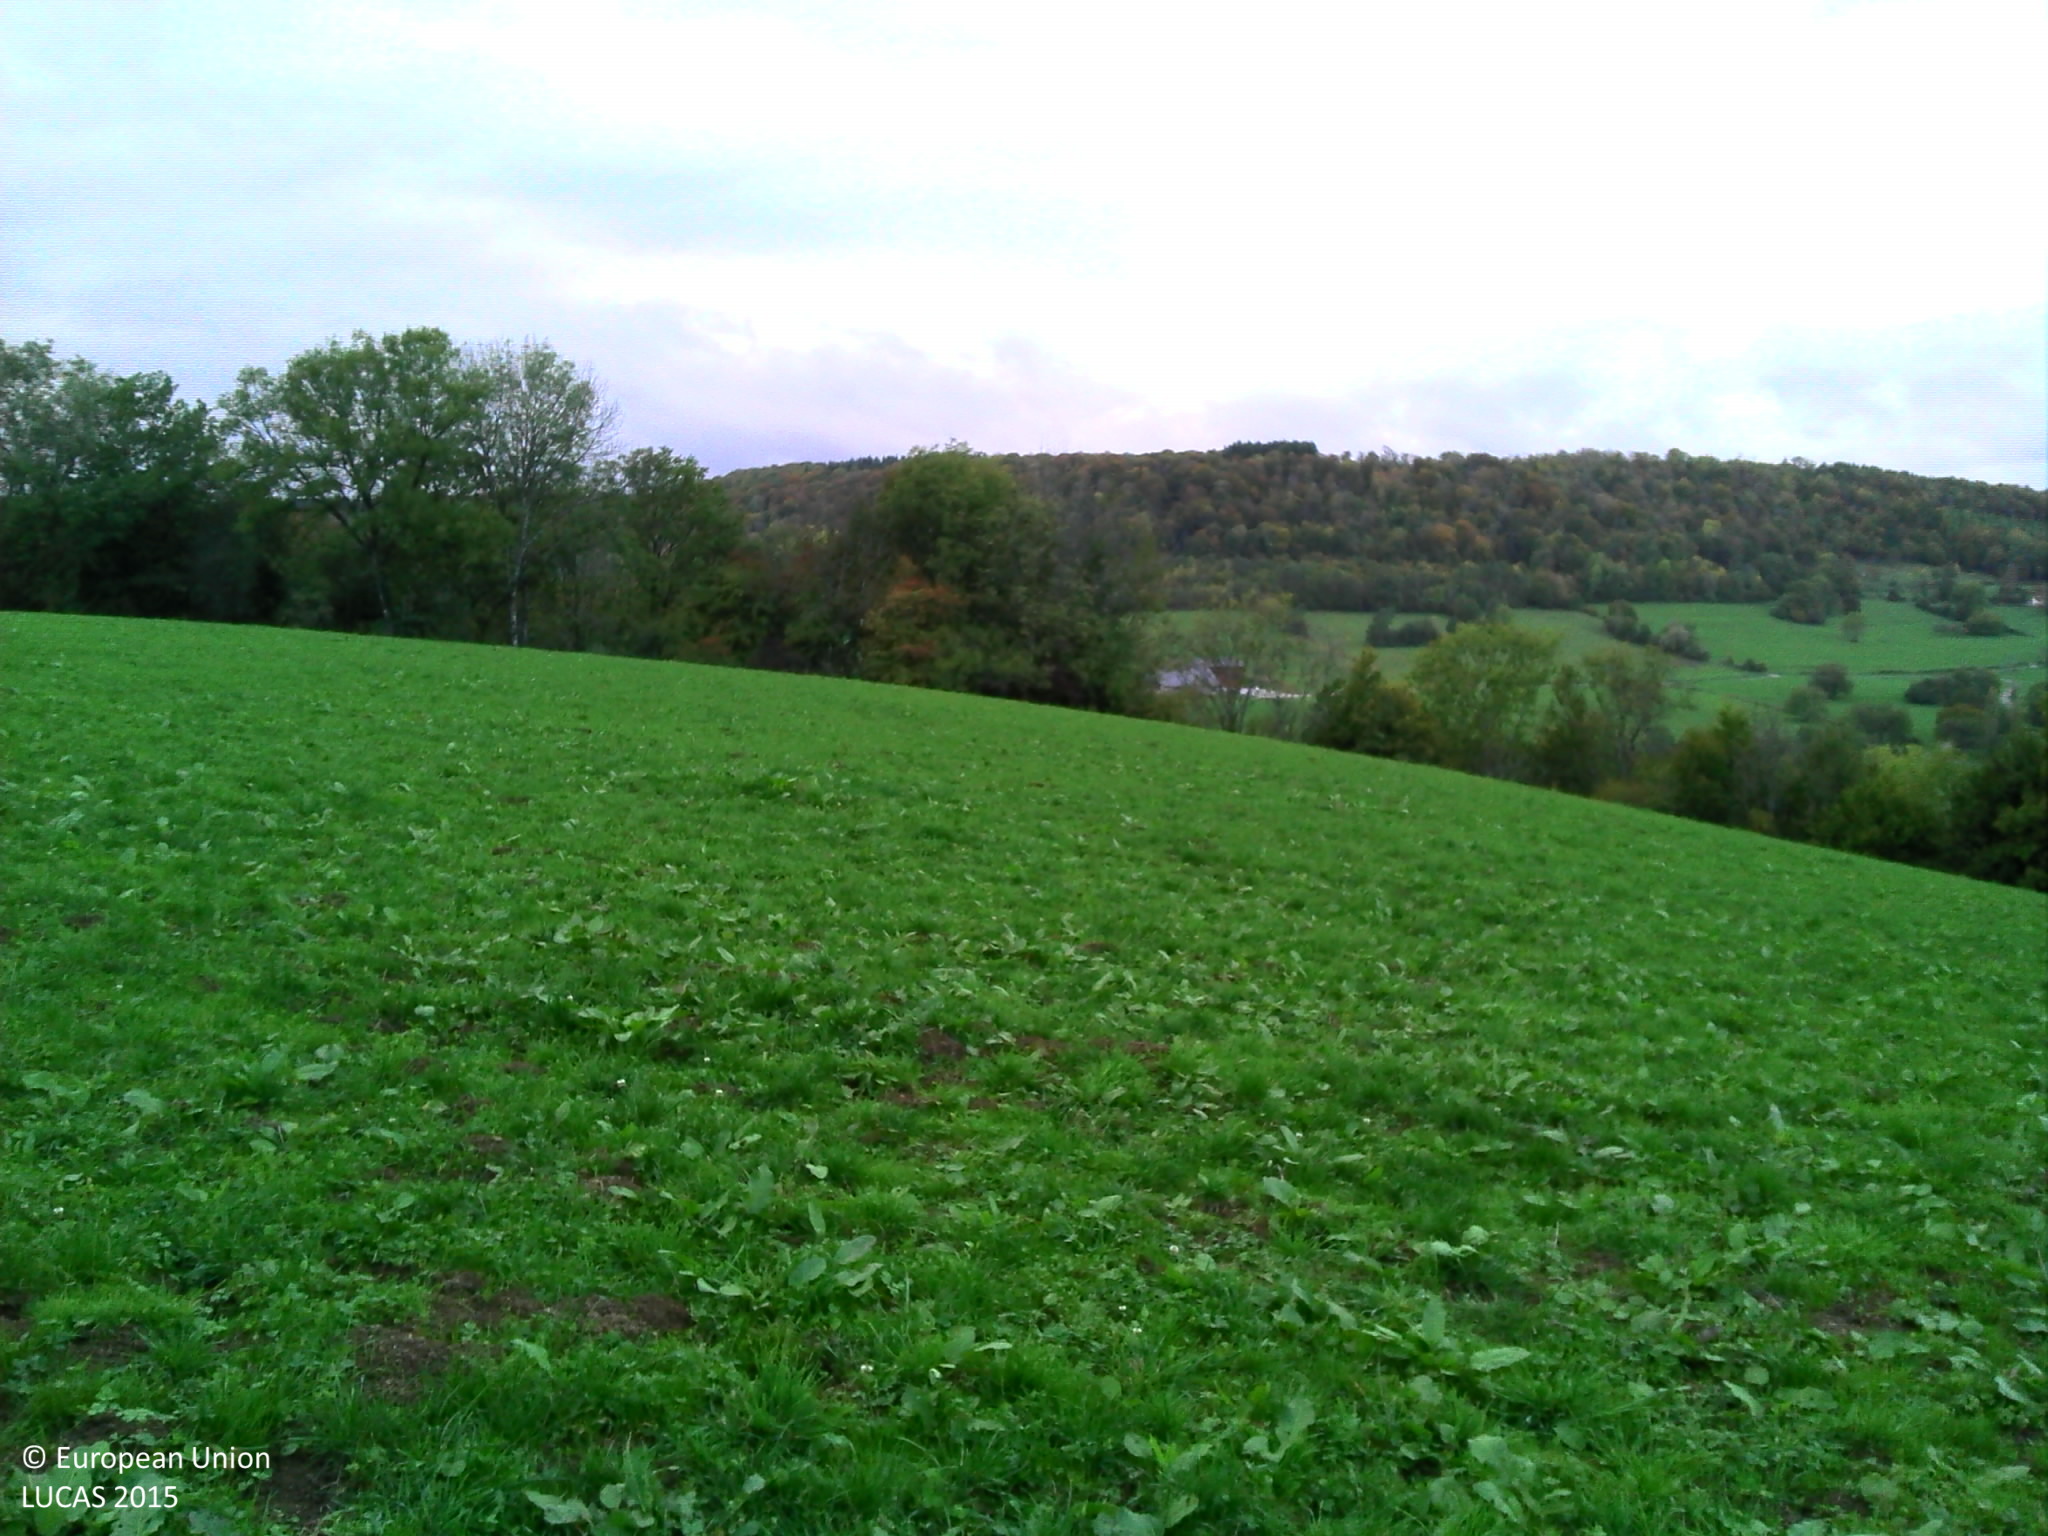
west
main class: Grassland
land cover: Grassland without tree/shrub cover
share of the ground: > 75 %
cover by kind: herbaceous plants 100 %
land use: Agriculture (excluding fallow land and kitchen gardens)
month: October
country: FR
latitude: 47.0891
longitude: 6.0369
